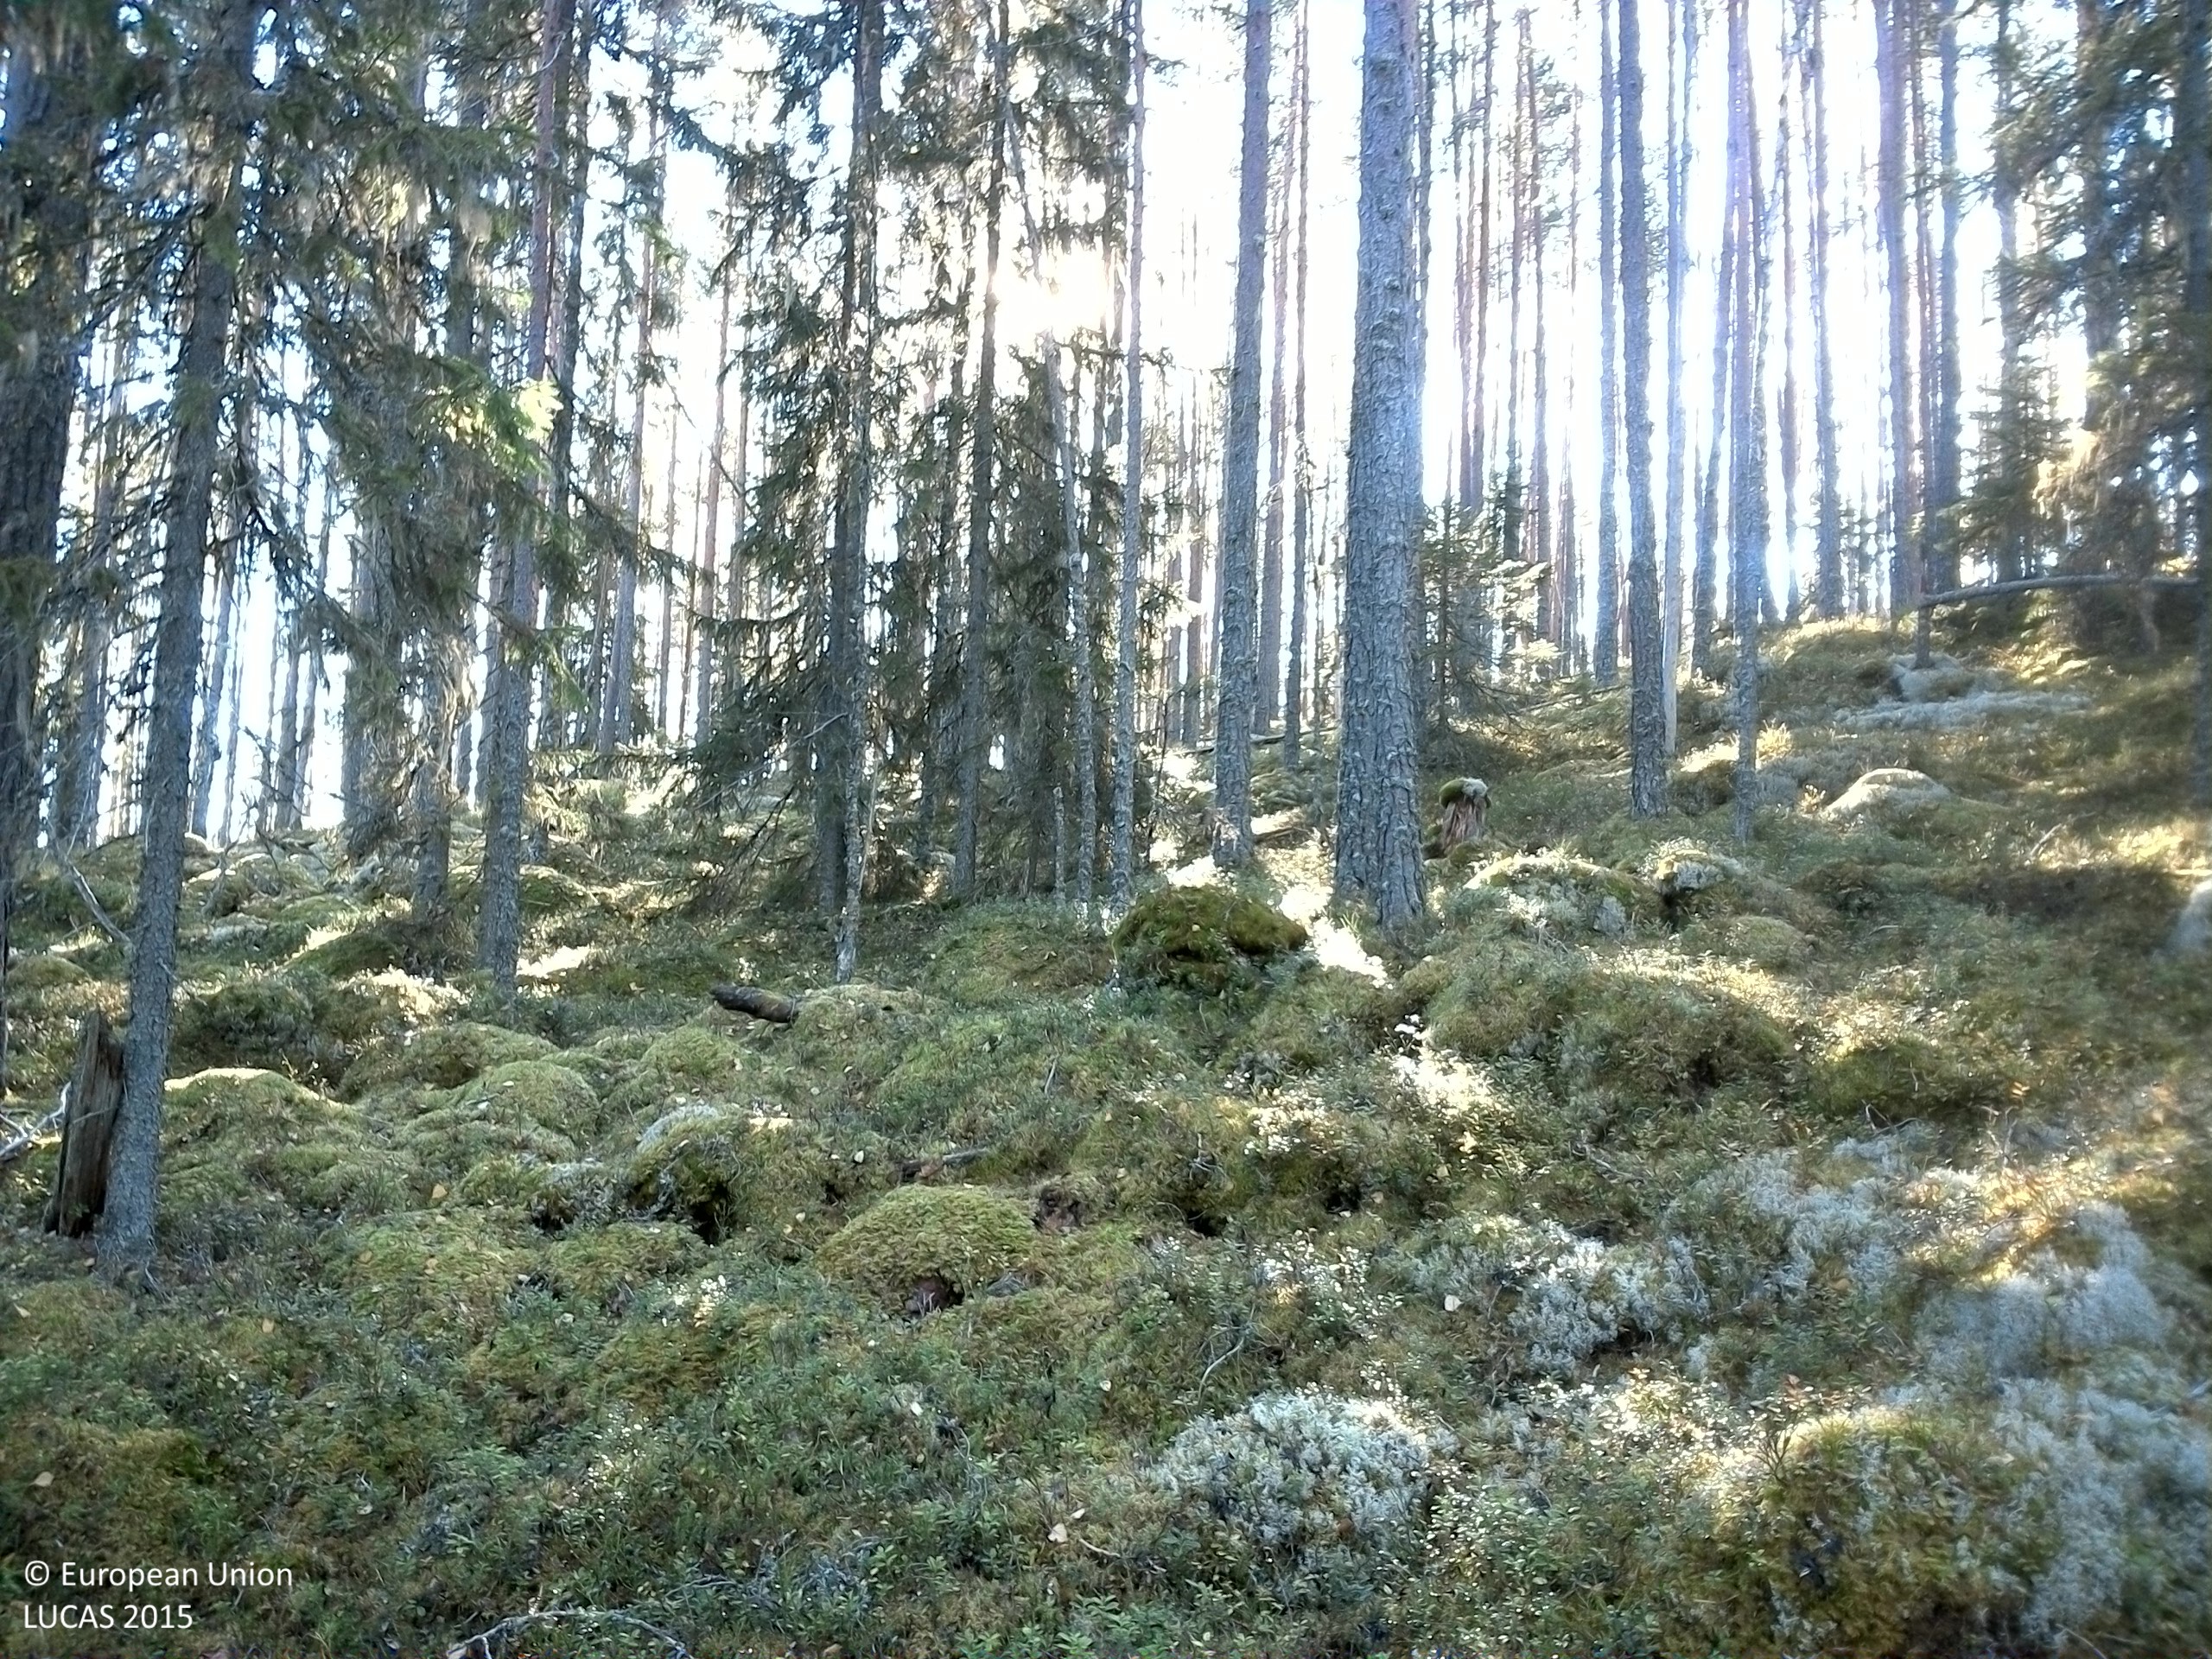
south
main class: Woodland
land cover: Pine dominated coniferous woodland
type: boreal forest
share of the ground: > 75 %
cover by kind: coniferous forest trees 75 %, shrubs 15 %, lichens and mosses 10 %
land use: Forestry
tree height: > 5 m
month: October
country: SE
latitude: 61.1427
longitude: 14.3143
